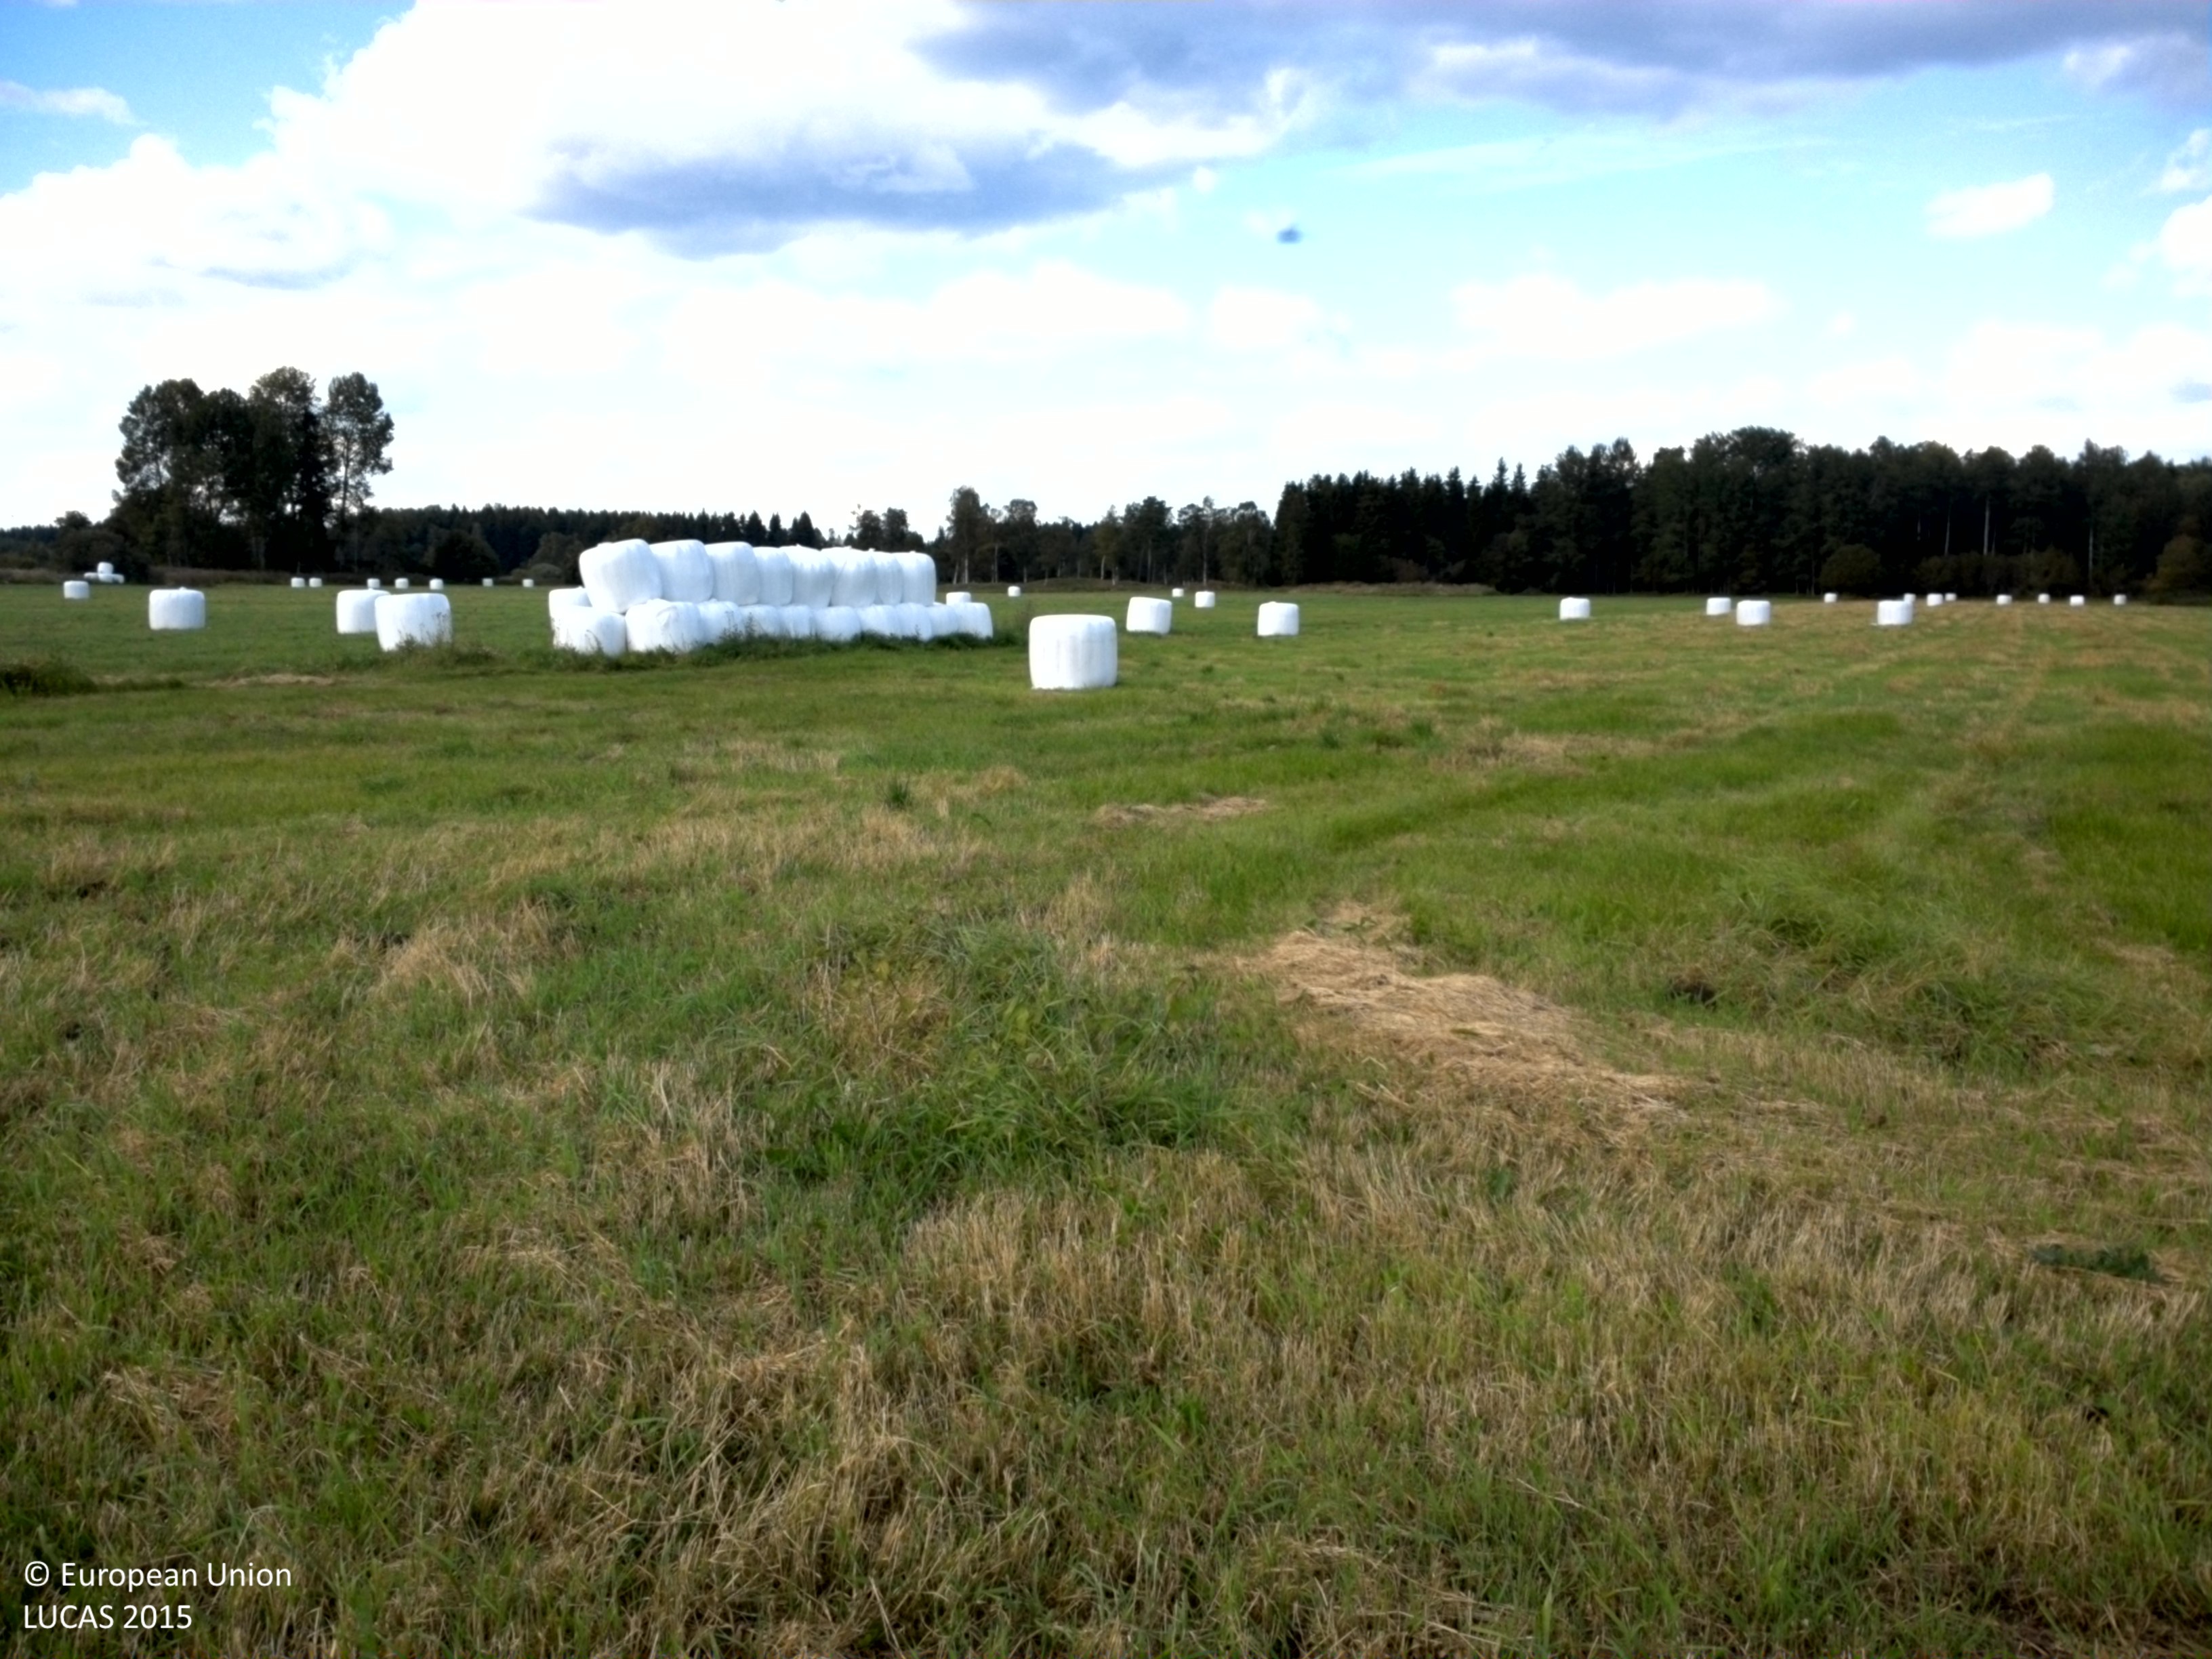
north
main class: Cropland
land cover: Other leguminous and mixtures for fodder
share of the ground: 25 - 50 %
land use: Agriculture (excluding fallow land and kitchen gardens)
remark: Harvested field
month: August
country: SE
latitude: 60.0607
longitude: 17.6998
